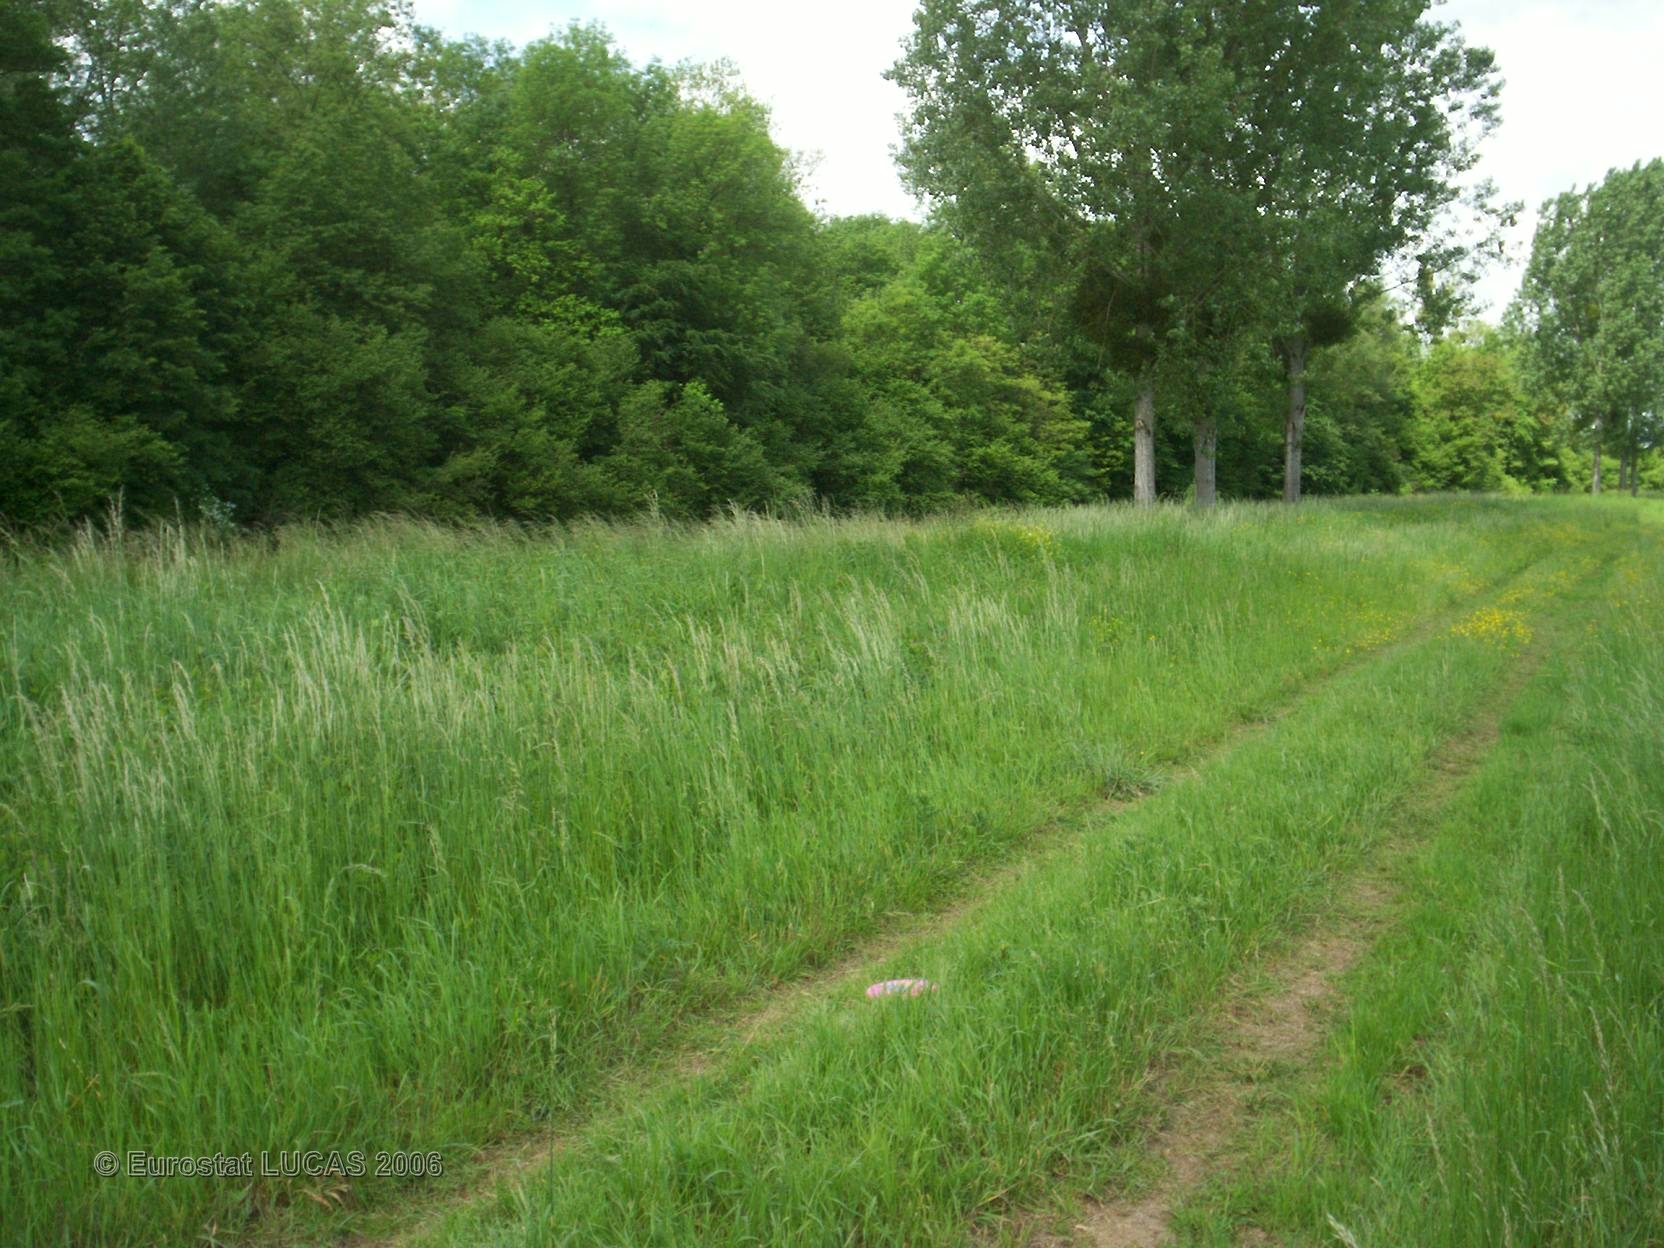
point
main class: Grassland
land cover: Grassland without tree/shrub cover
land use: Agriculture (excluding fallow land and kitchen gardens)
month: May
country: FR
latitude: 49.4881
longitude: 4.4051
